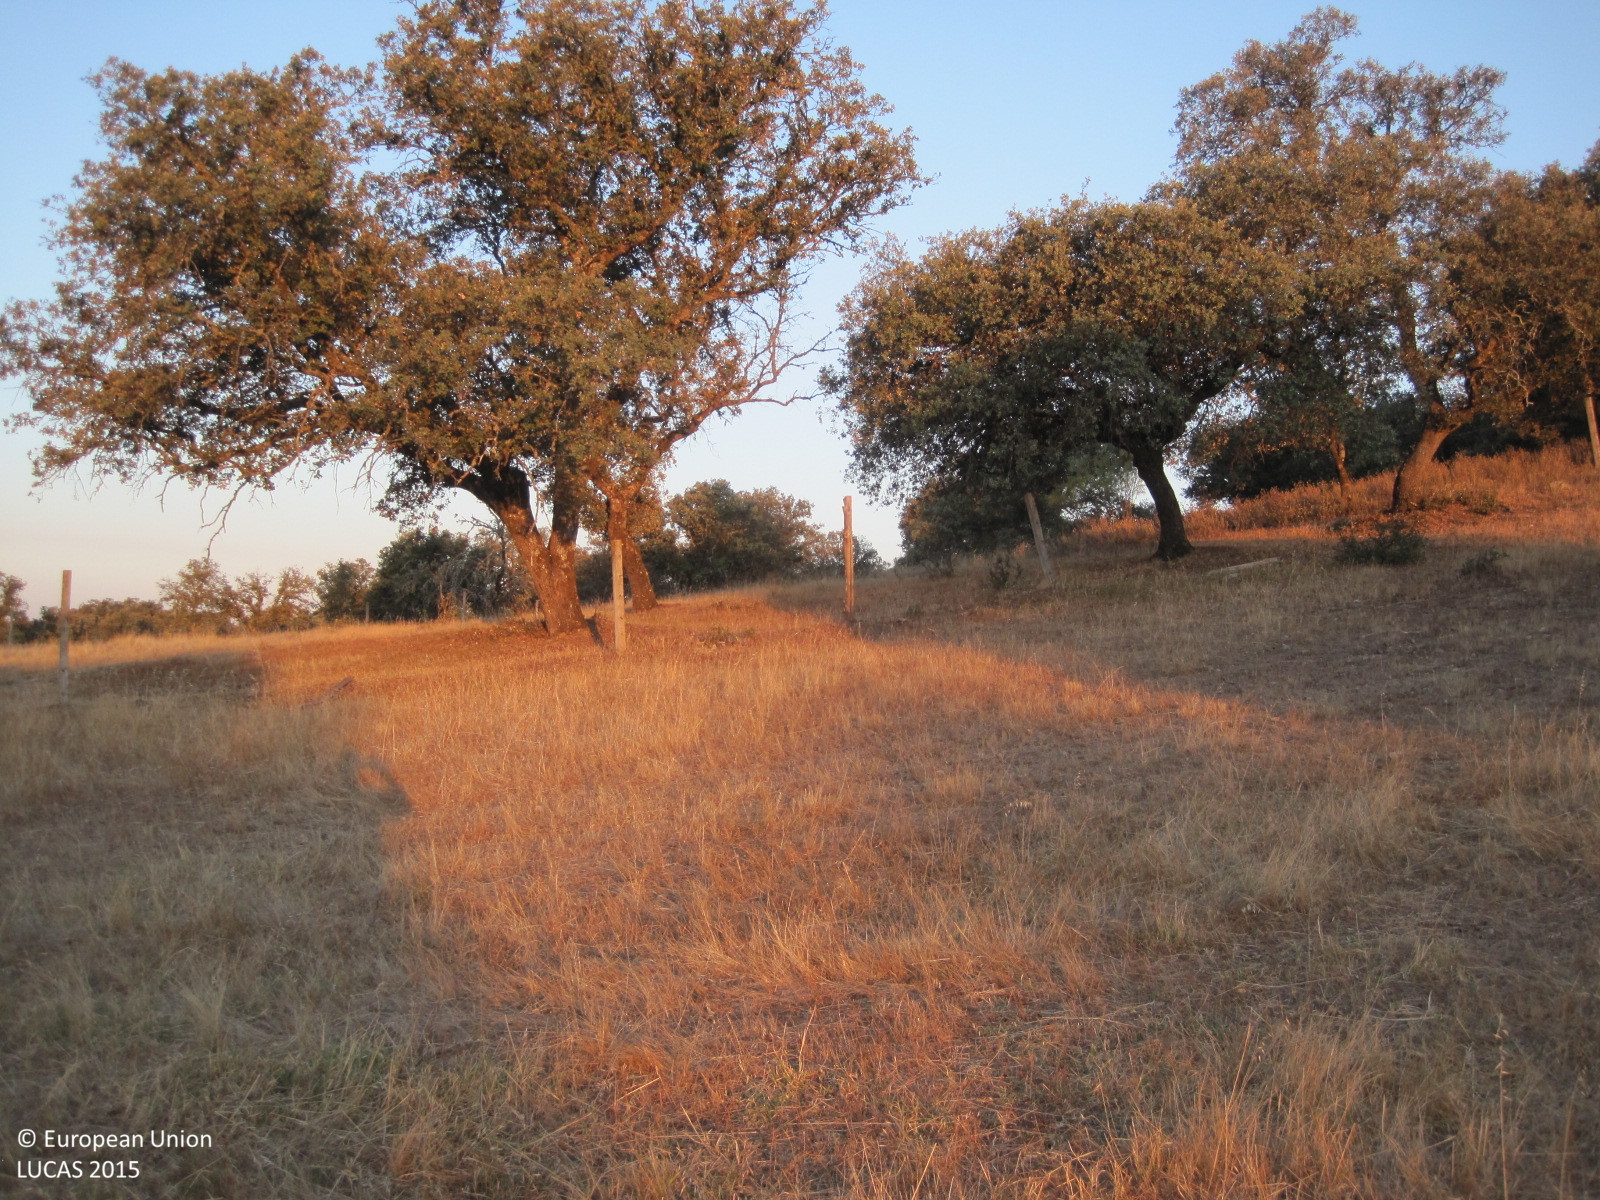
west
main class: Grassland
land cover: Grassland with sparse tree/shrub cover
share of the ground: > 75 %
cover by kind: herbaceous plants 95 %, broadleaved forest trees 5 %
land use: Agriculture (excluding fallow land and kitchen gardens)
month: July
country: ES
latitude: 40.2353
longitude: -4.8261
